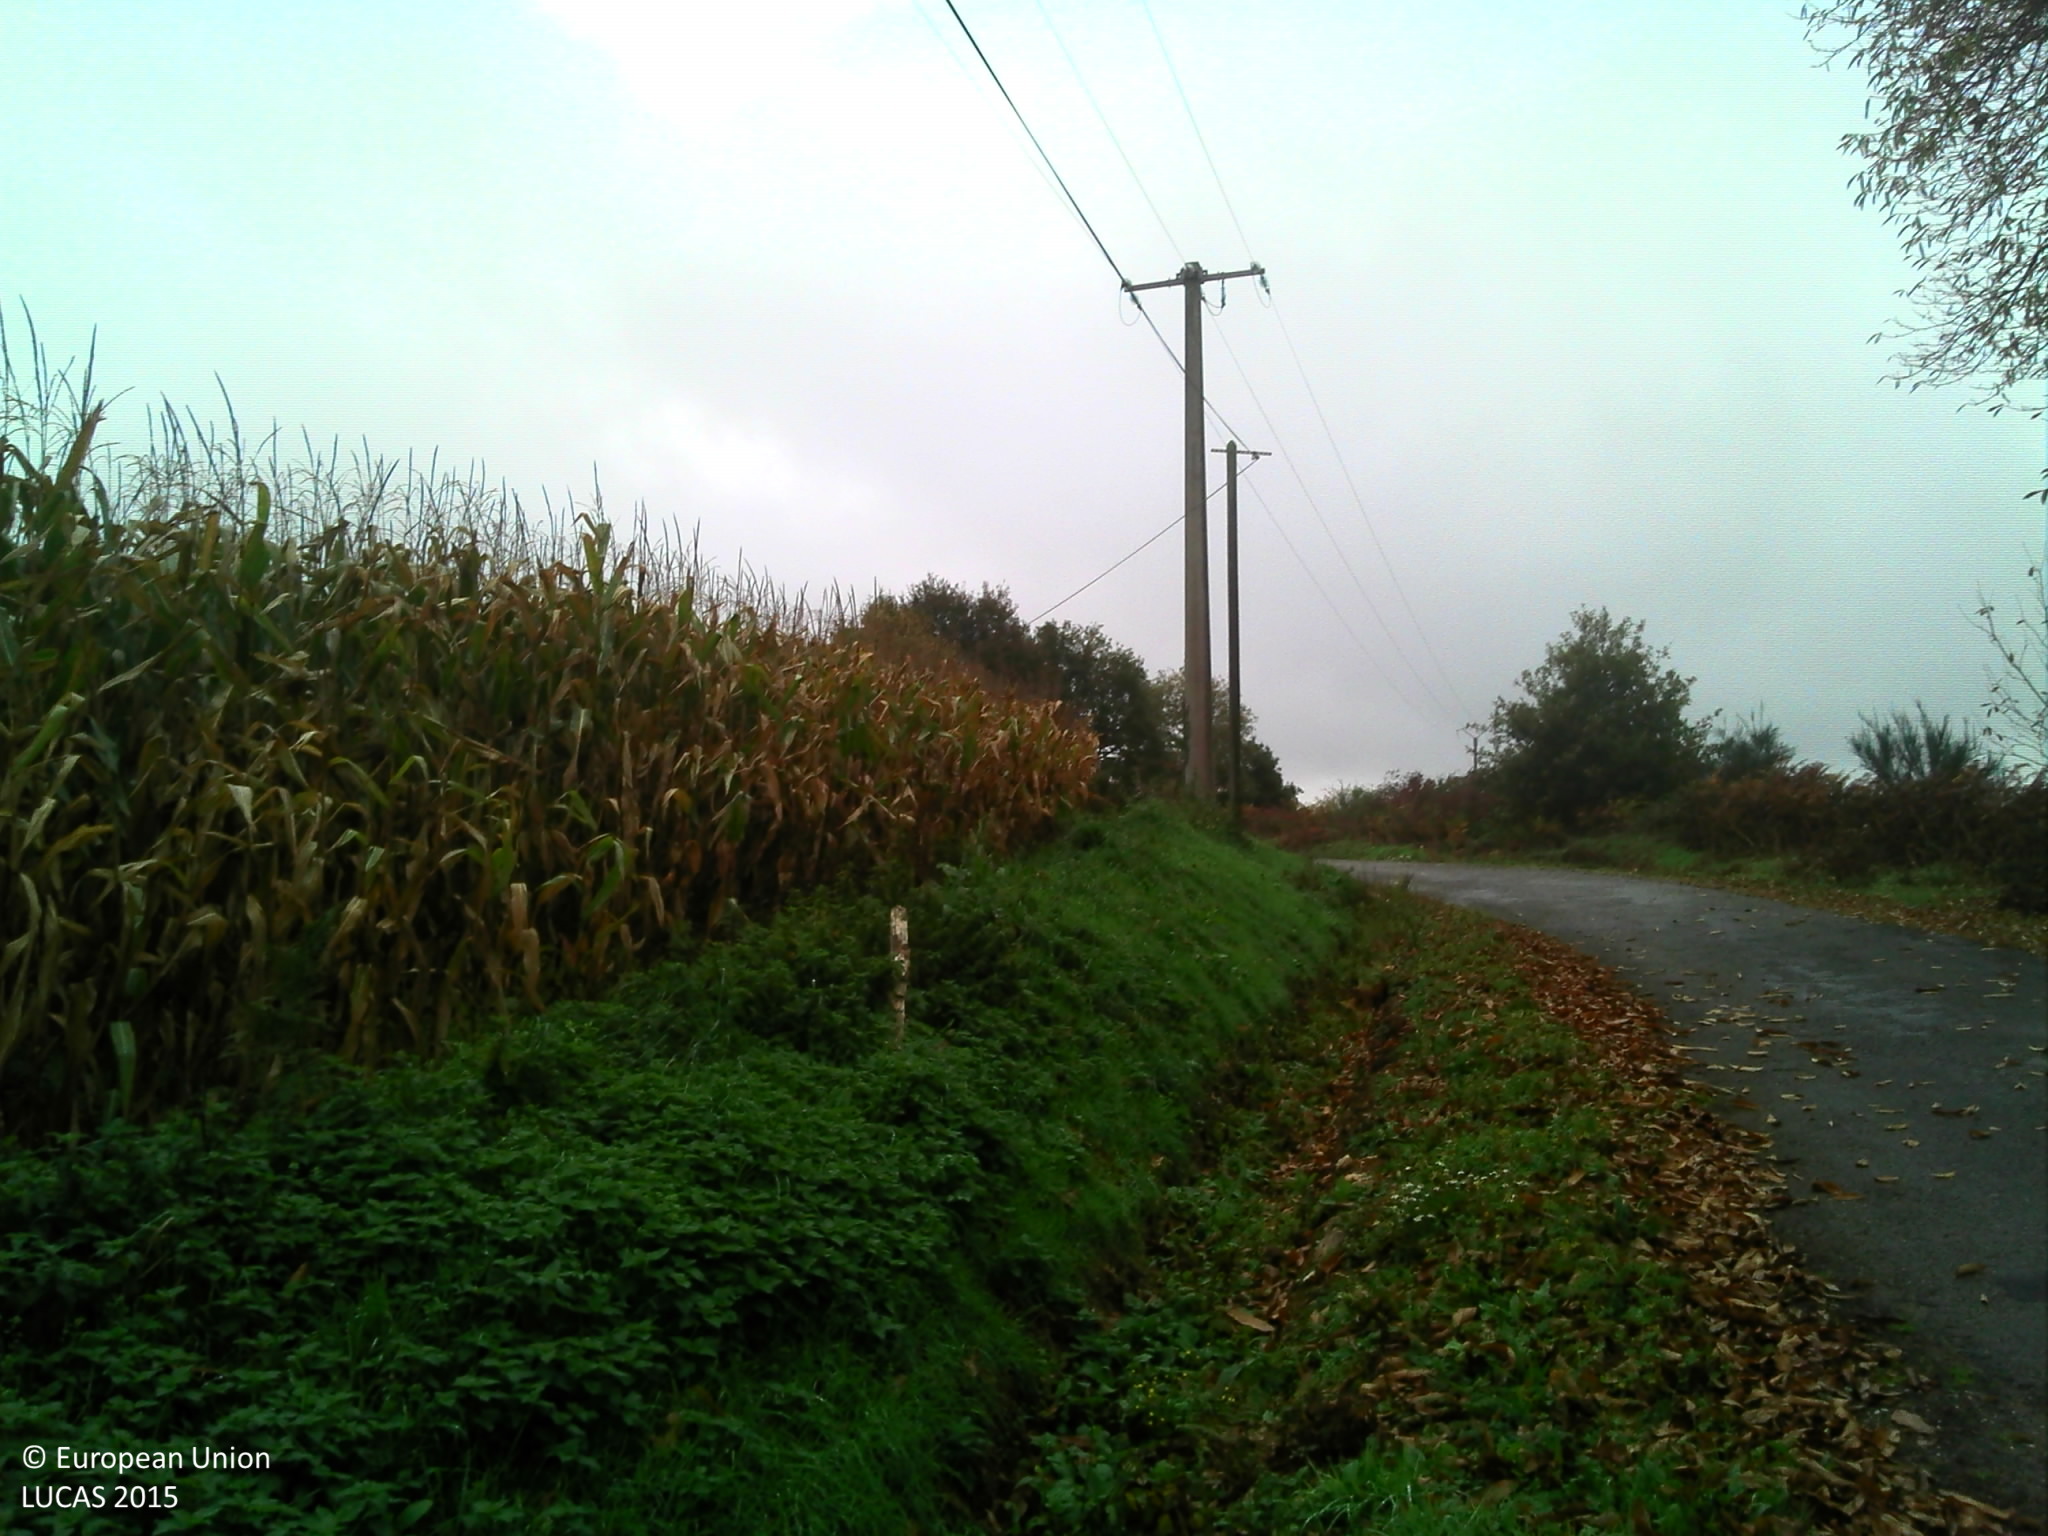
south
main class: Cropland
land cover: Maize
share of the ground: > 75 %
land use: Agriculture (excluding fallow land and kitchen gardens)
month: November
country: FR
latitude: 47.9725
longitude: -3.0487
